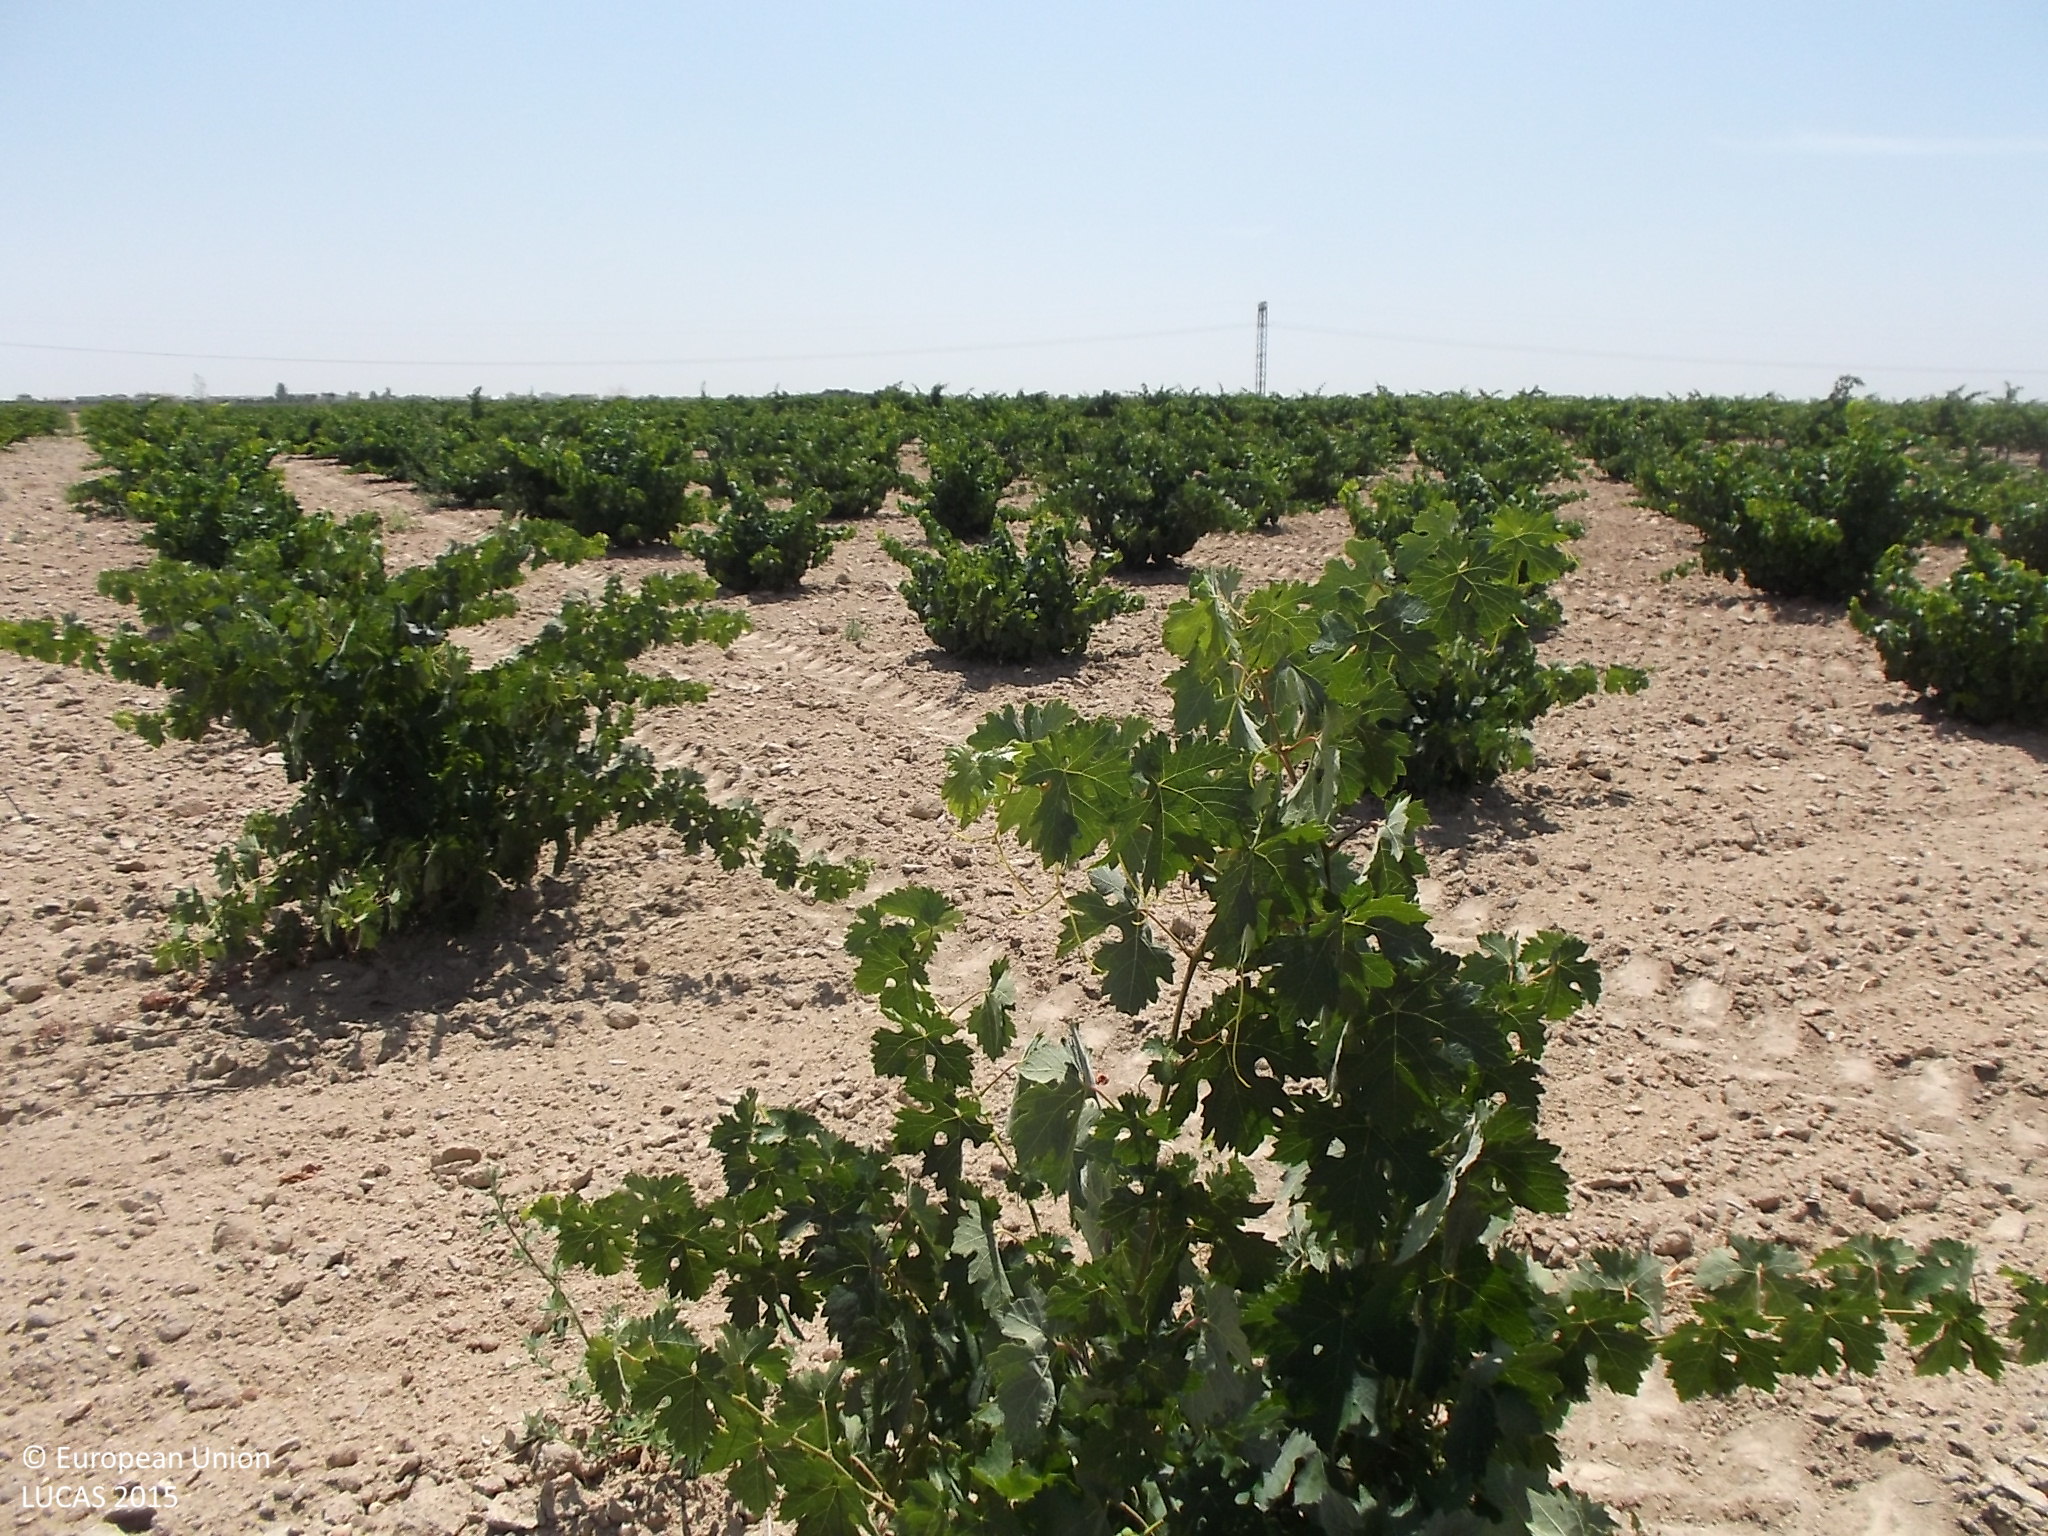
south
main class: Cropland
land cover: Vineyards
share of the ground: 10 - 25 %
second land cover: Other bare soil
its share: > 75 %
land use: Agriculture (excluding fallow land and kitchen gardens)
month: July
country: ES
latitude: 41.5544
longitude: -5.3173
